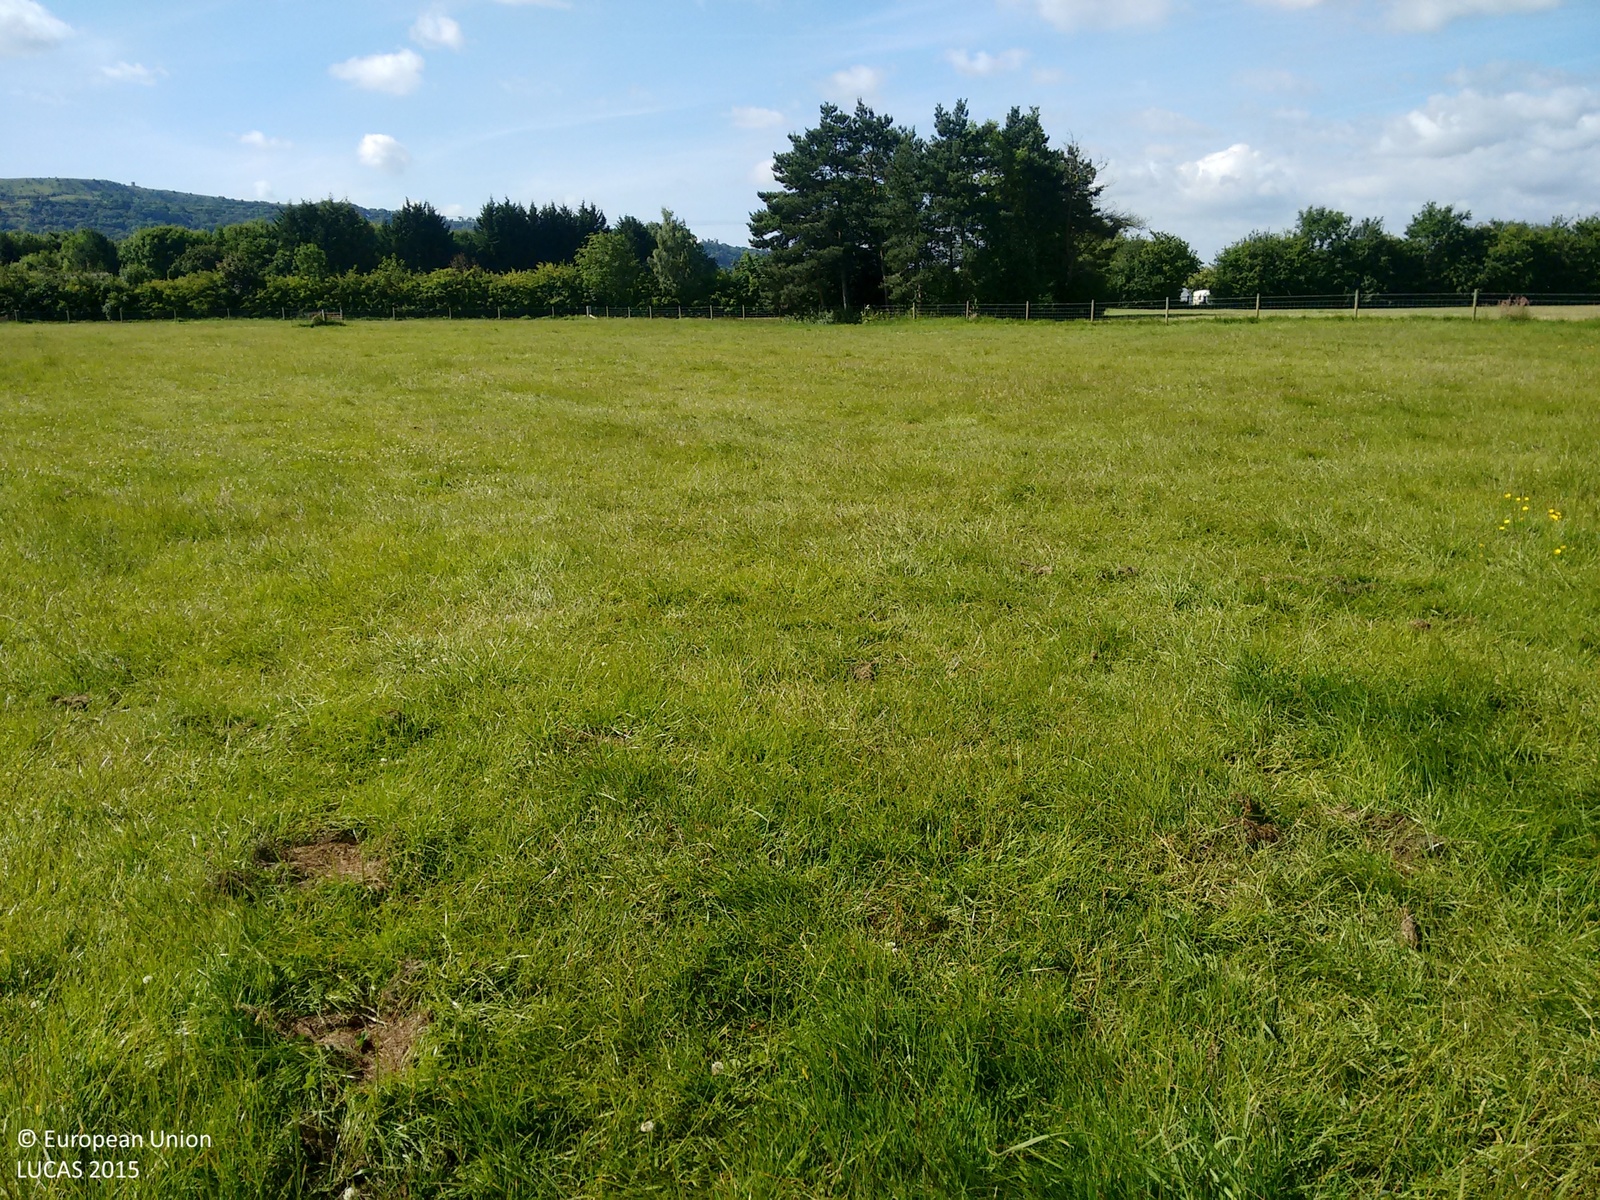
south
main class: Grassland
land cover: Grassland without tree/shrub cover
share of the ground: > 75 %
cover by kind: herbaceous plants 100 %
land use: Sport
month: June
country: GB
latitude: 52.0862
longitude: -2.0703
